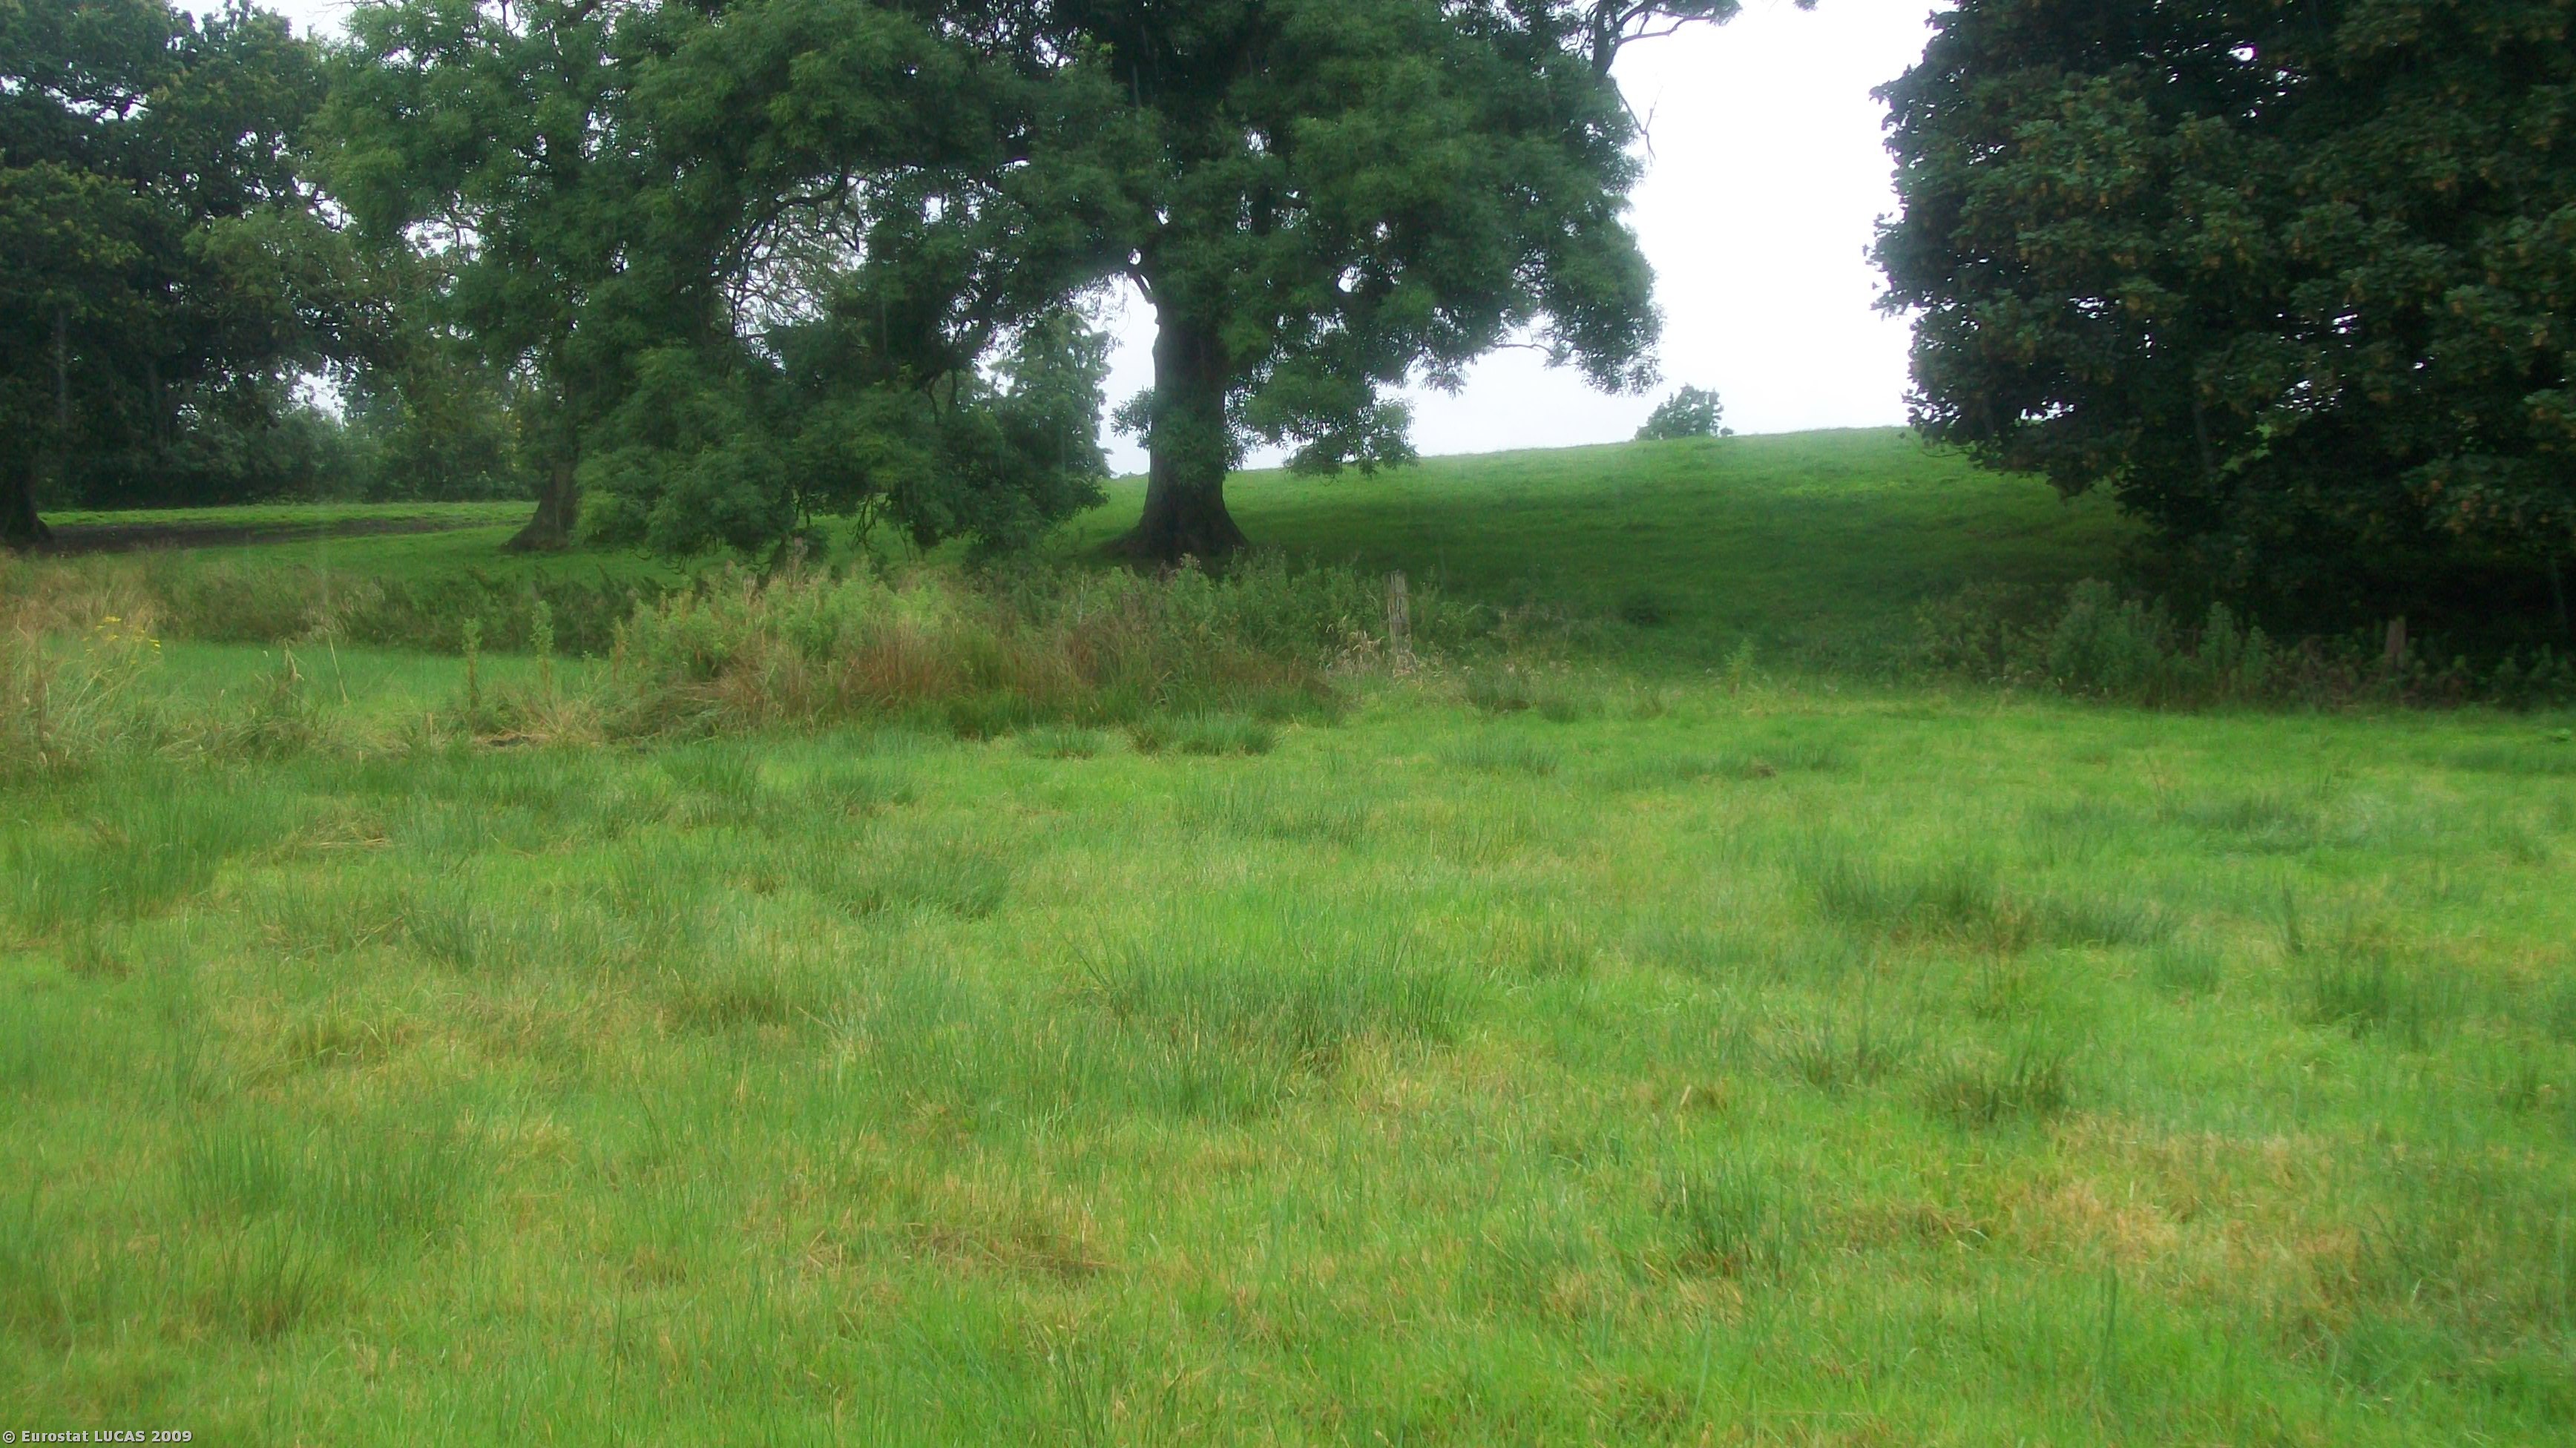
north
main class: Woodland
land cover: Broadleaved woodland
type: non-riverine alder, birch or aspen forest
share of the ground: > 75 %
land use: Unused
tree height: > 5 m
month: July
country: GB
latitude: 53.0070
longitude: -2.6617
